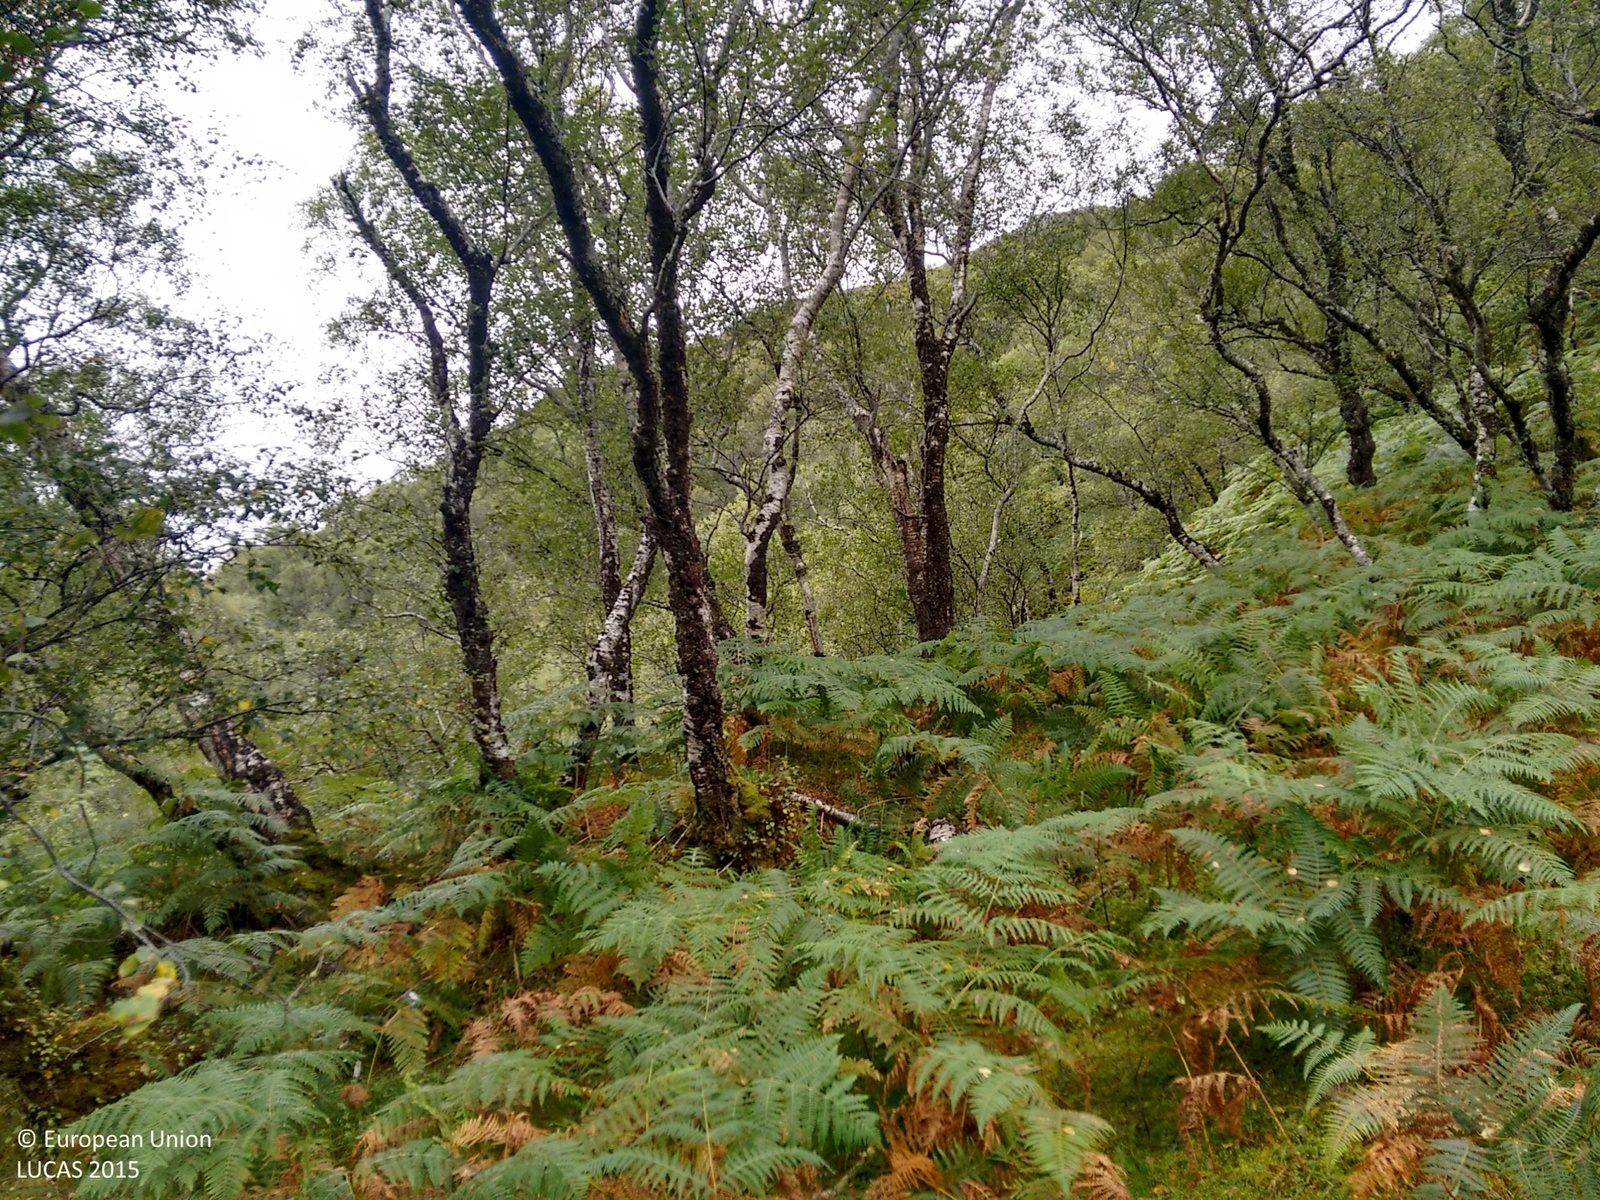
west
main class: Woodland
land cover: Broadleaved woodland
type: floodplain forest
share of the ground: > 75 %
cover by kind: broadleaved forest trees 90 %, herbaceous plants 10 %
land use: Agriculture (excluding fallow land and kitchen gardens)
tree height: > 5 m
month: September
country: GB
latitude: 57.5268
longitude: -5.7007
